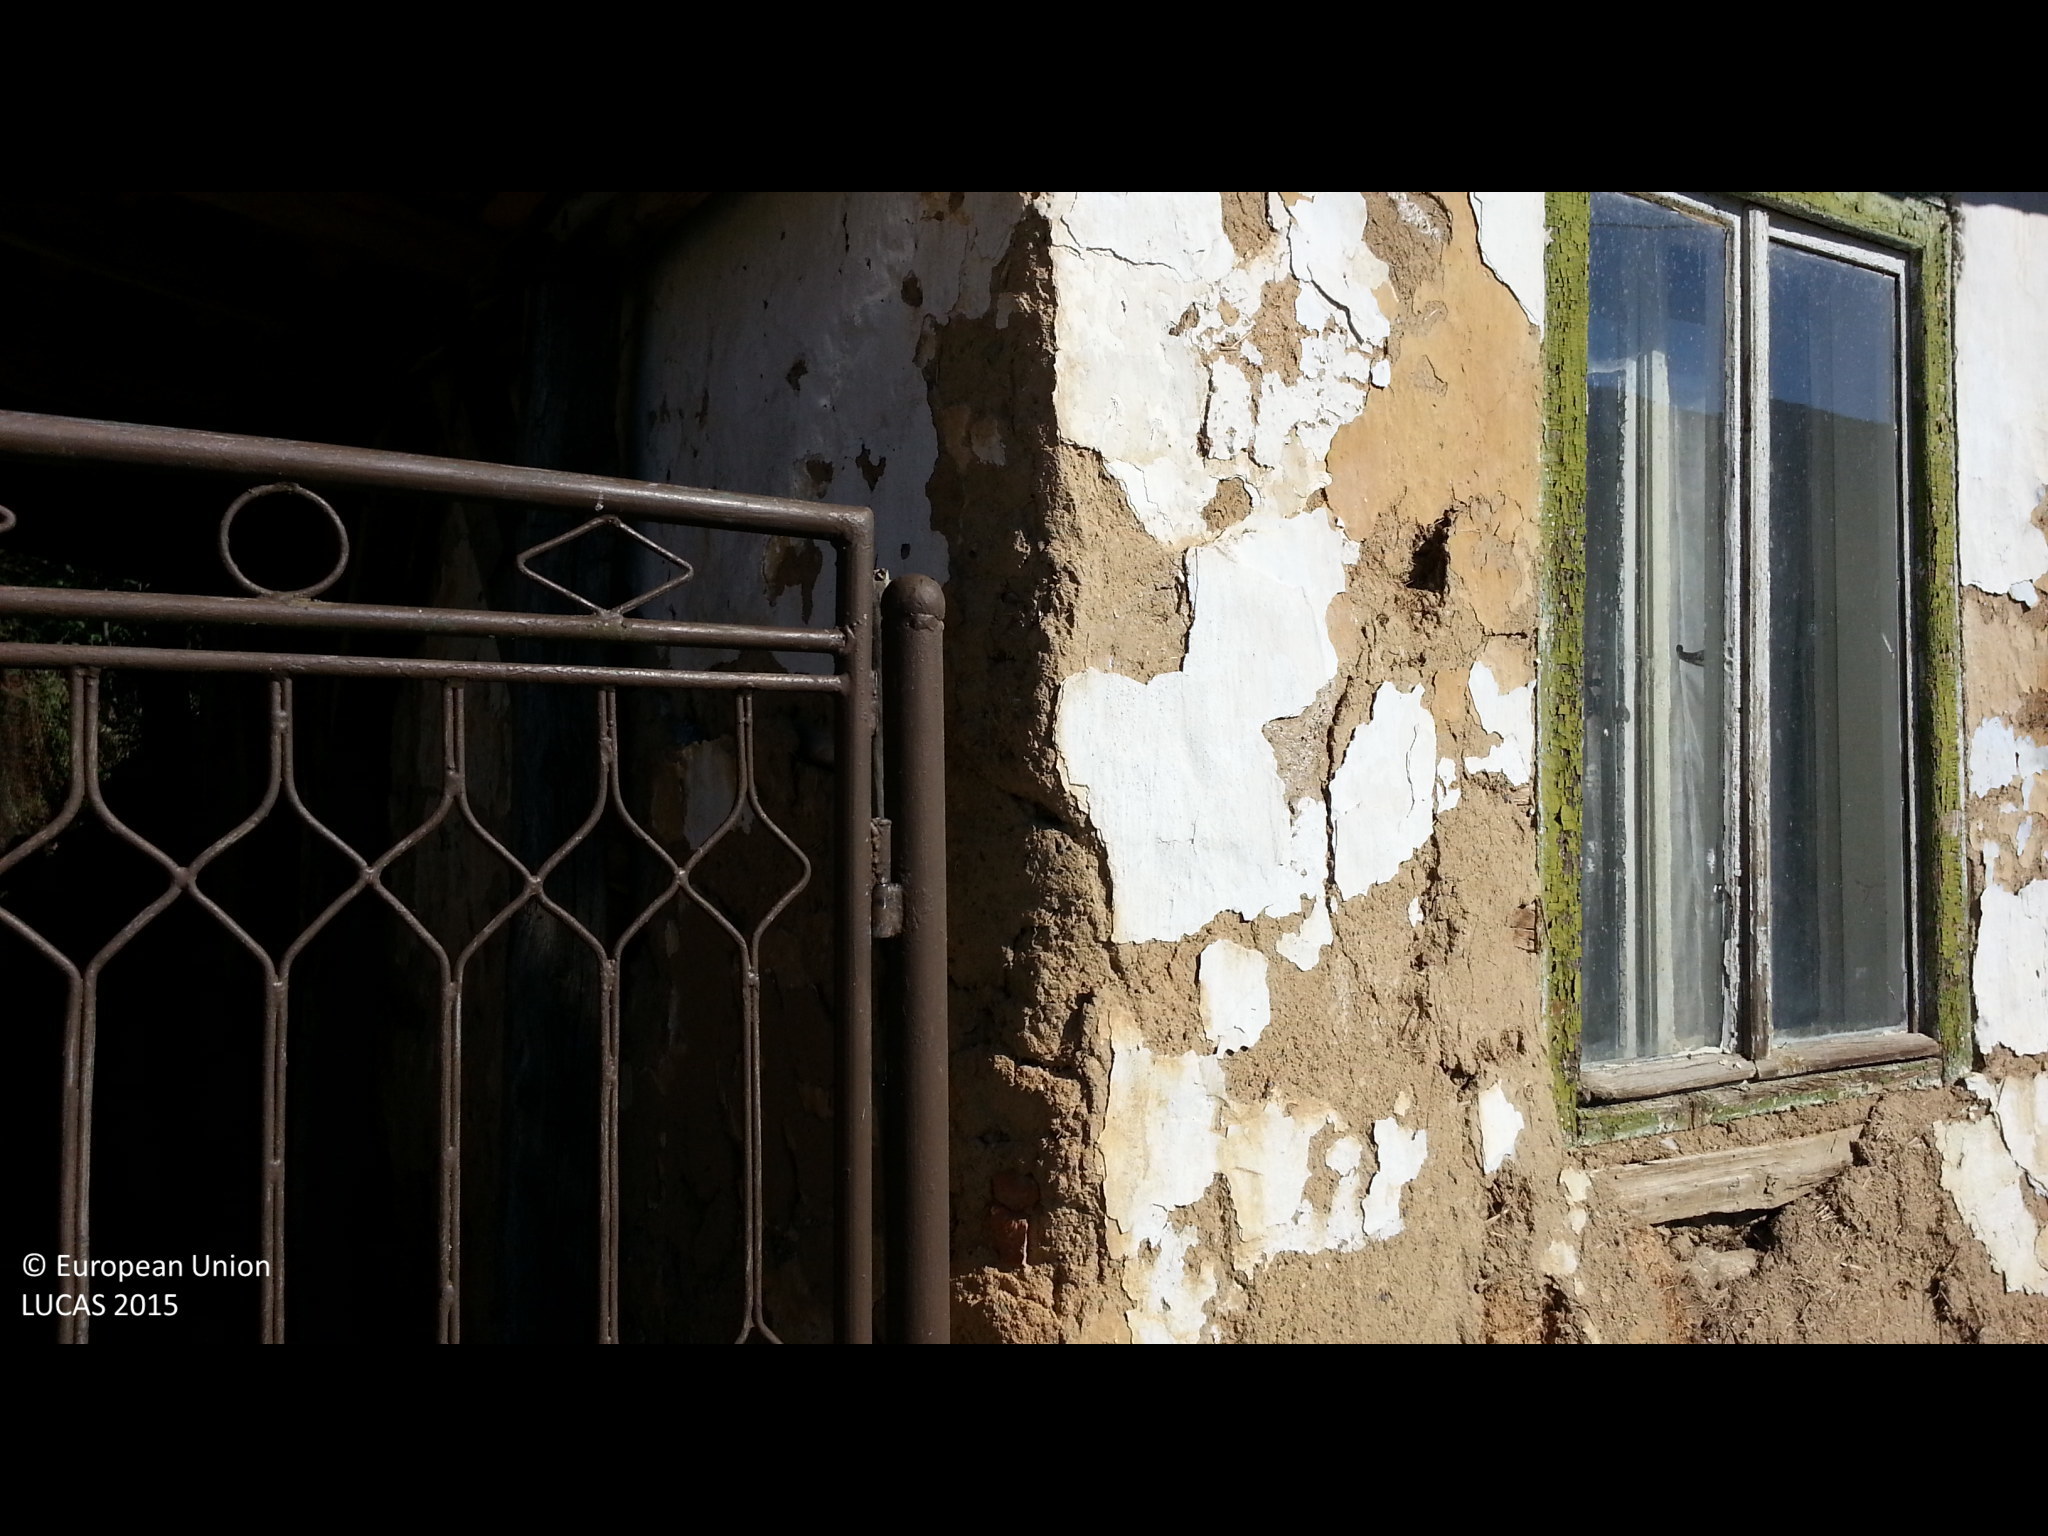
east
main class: Grassland
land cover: Grassland with sparse tree/shrub cover
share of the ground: > 75 %
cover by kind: herbaceous plants 90 %, broadleaved forest trees 5 %, shrubs 5 %
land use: Residential
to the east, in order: Grassland with sparse tree/shrub cover; Artificial constructions in urban areas; Broadleaved woodland; Pine dominated coniferous woodland
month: October
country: BG
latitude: 42.6487
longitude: 22.5997
